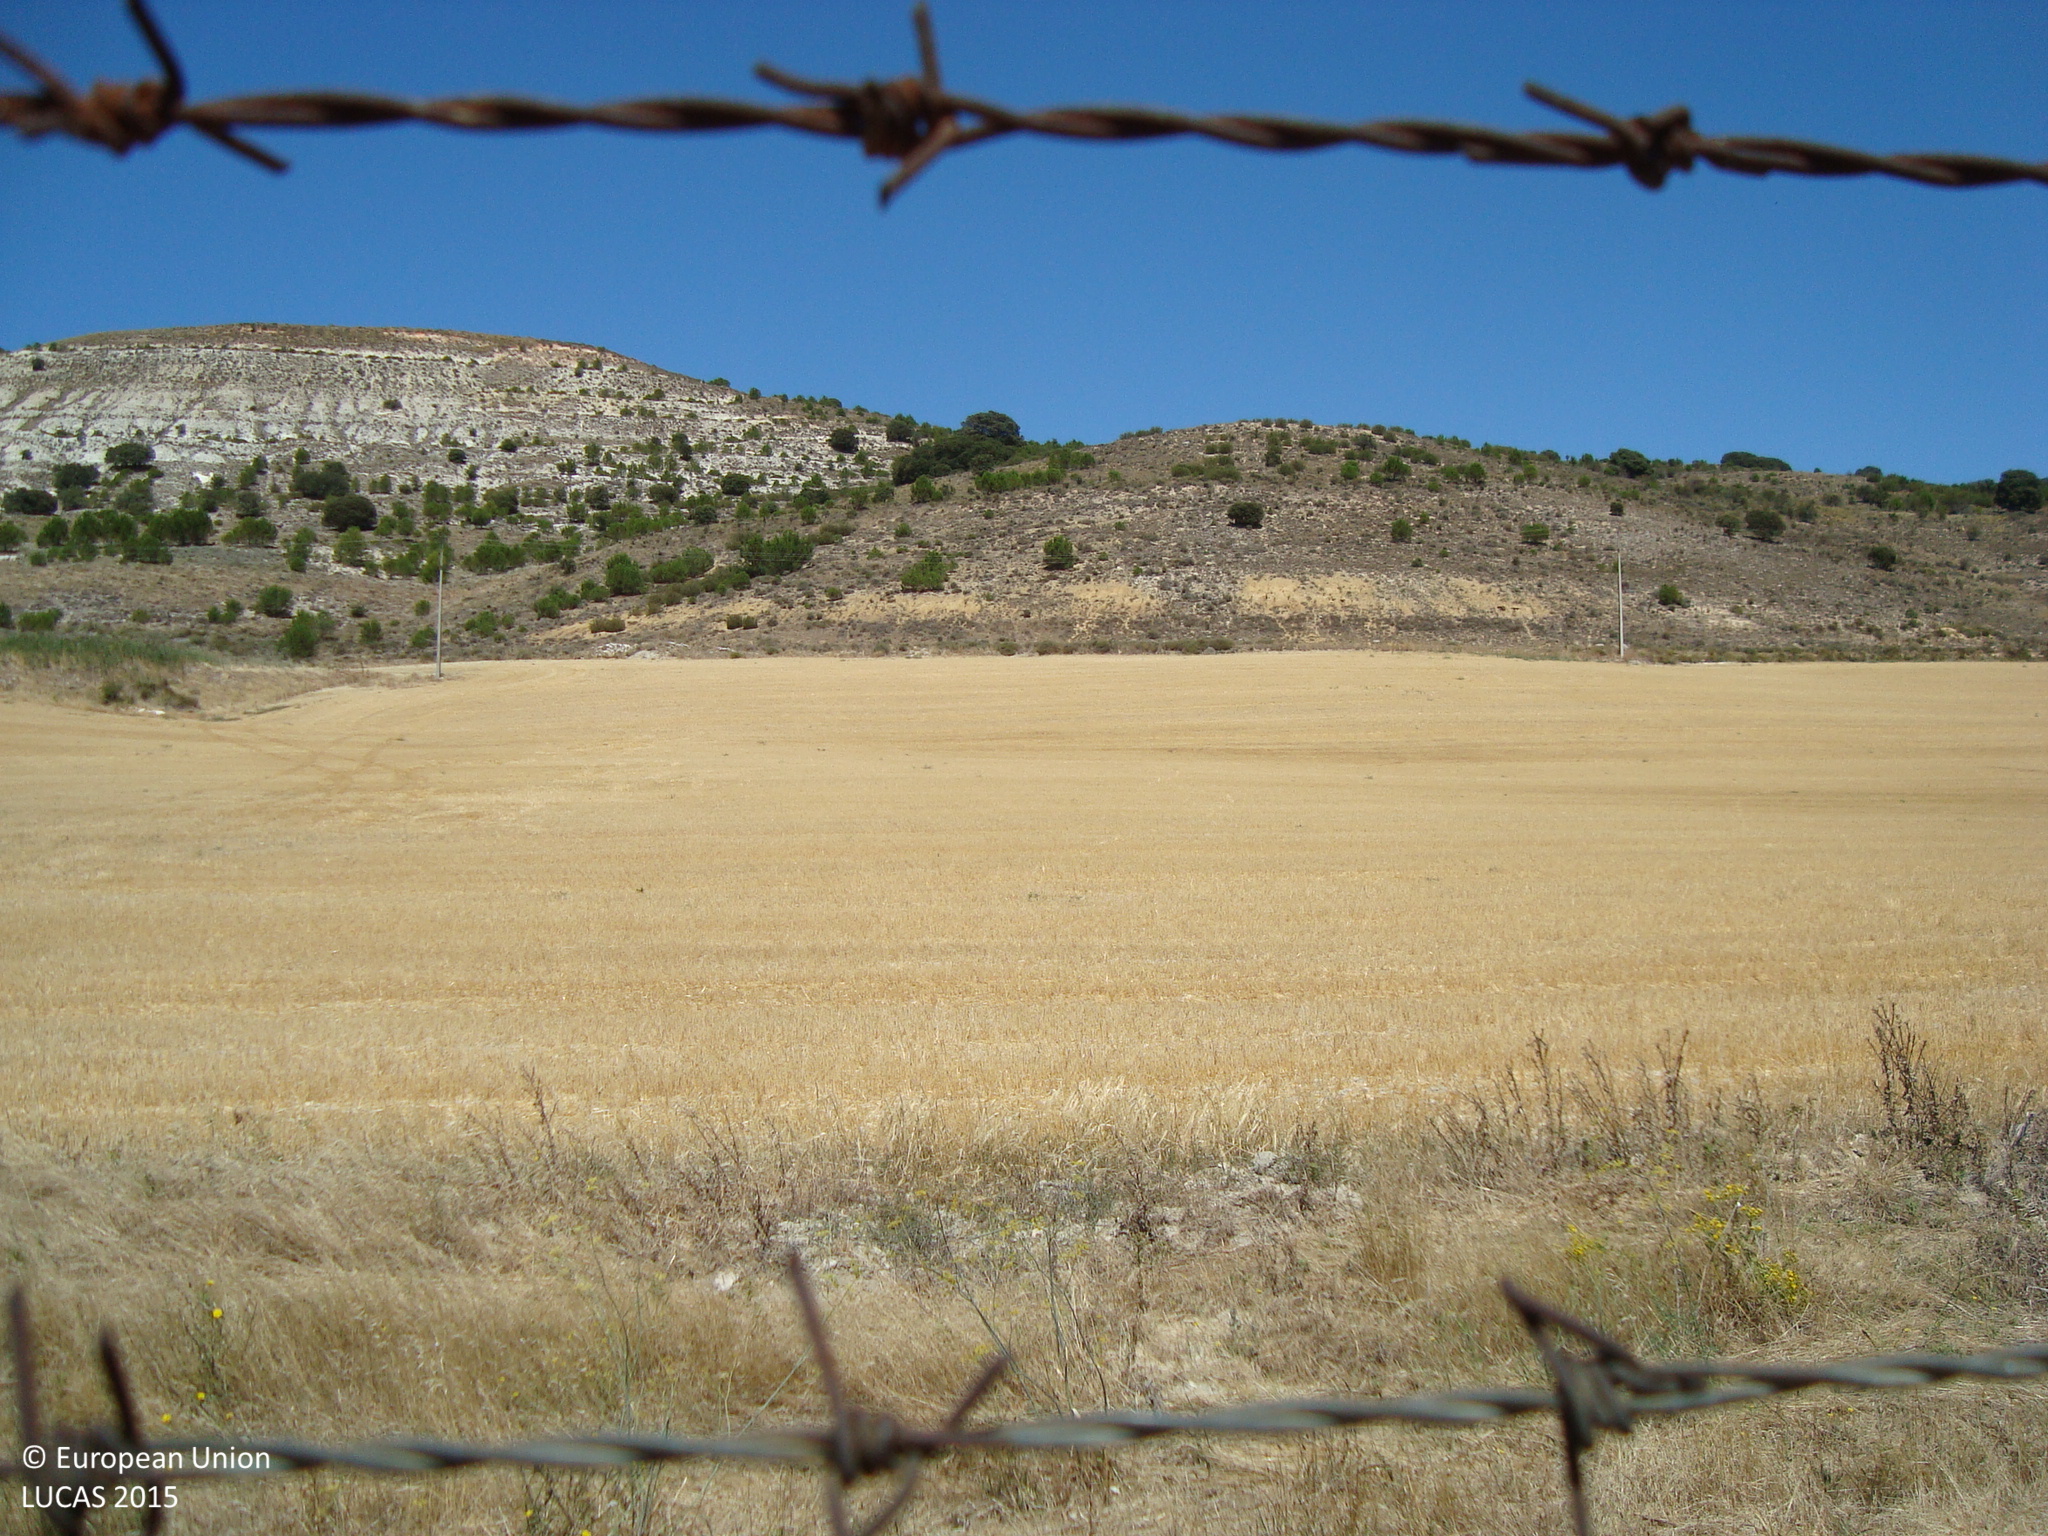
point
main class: Cropland
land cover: Barley
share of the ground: > 75 %
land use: Agriculture (excluding fallow land and kitchen gardens)
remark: Harvested field
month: August
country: ES
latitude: 42.1086
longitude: -4.1784
